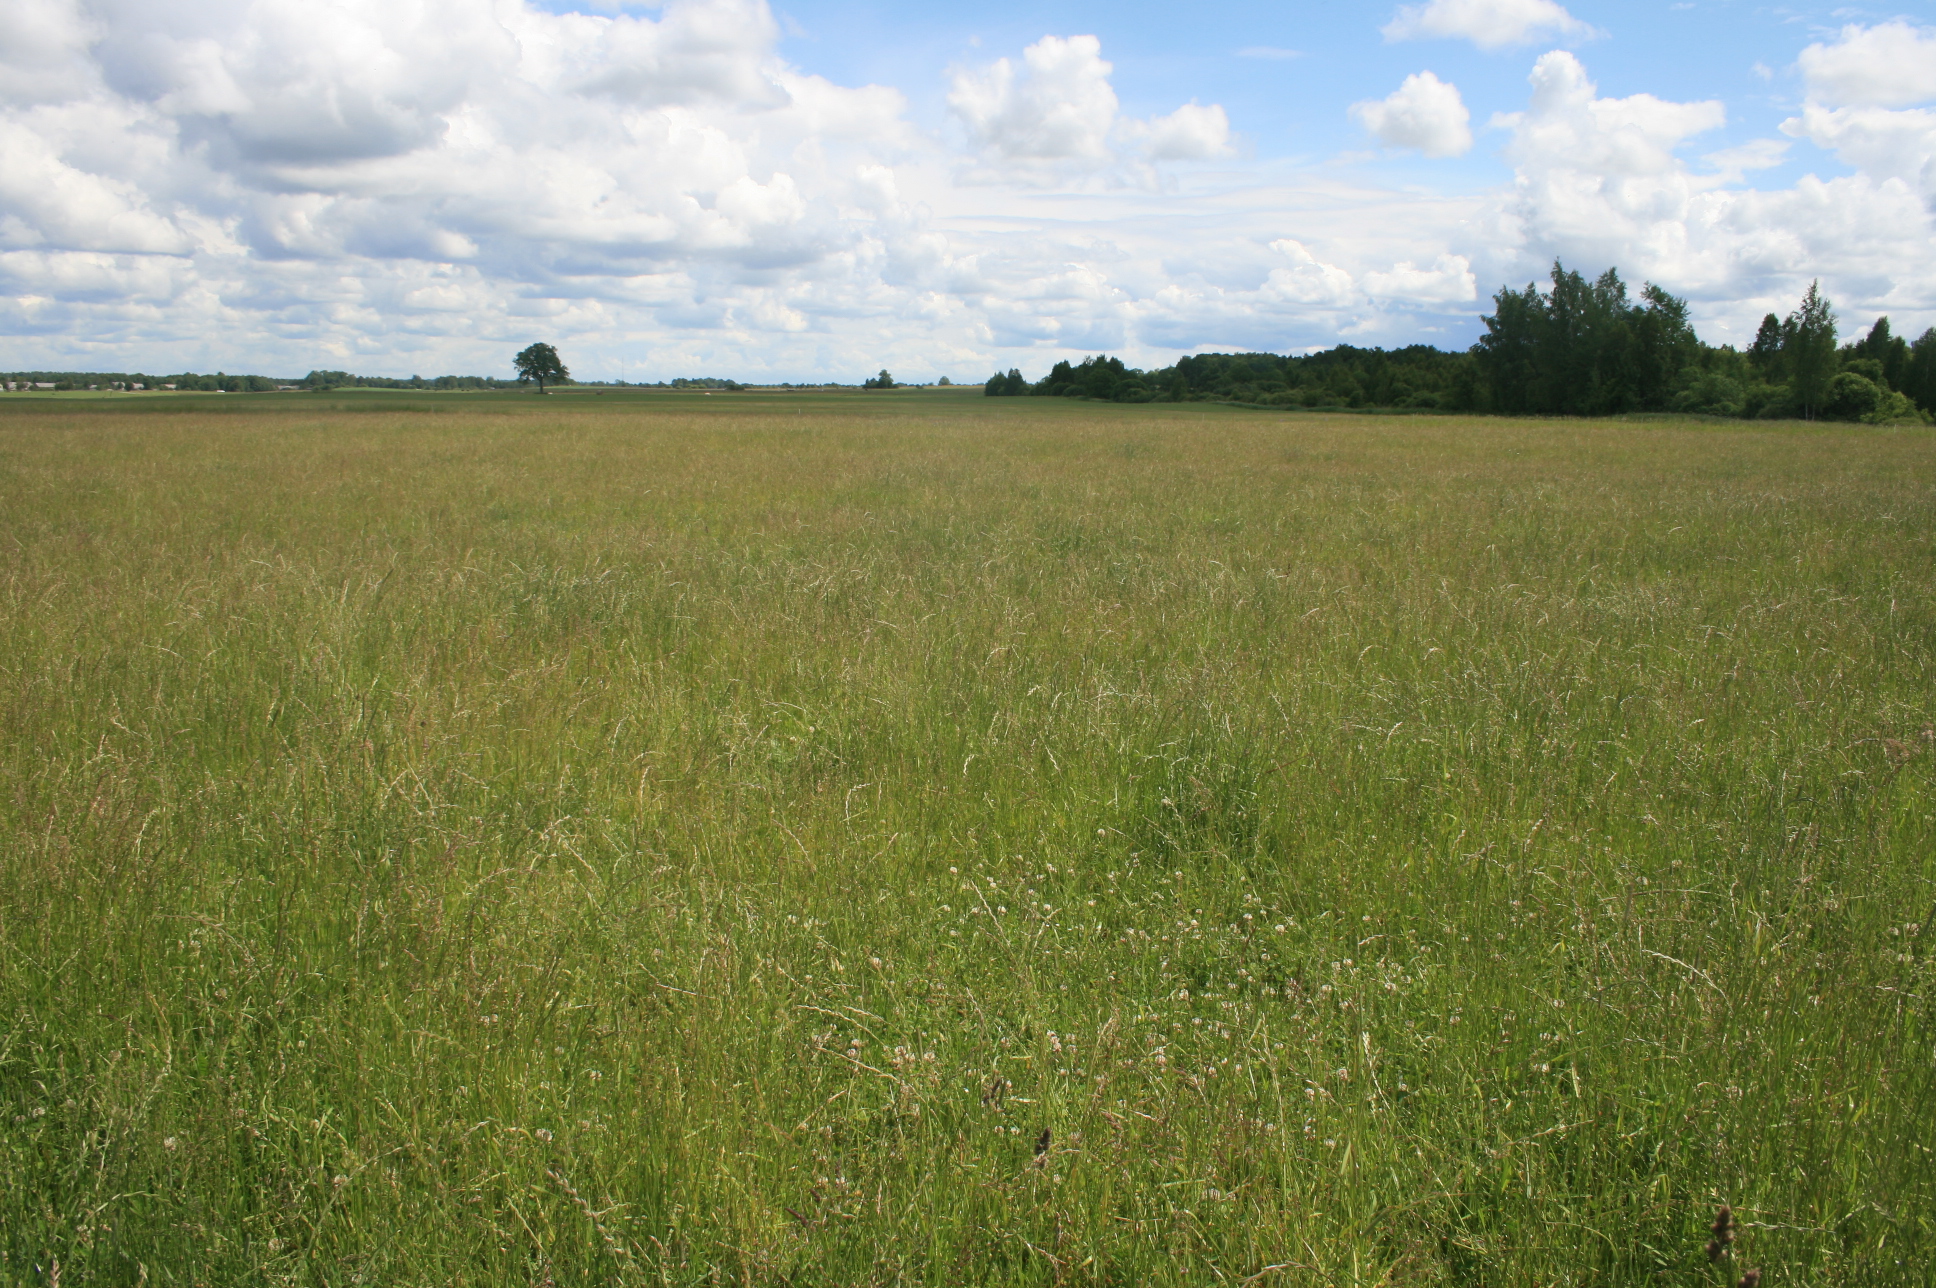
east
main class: Grassland
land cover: Grassland without tree/shrub cover
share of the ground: > 75 %
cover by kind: herbaceous plants 100 %
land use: Agriculture (excluding fallow land and kitchen gardens)
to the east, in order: Grassland without tree/shrub cover
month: June
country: LT
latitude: 55.2703
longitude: 22.0637
